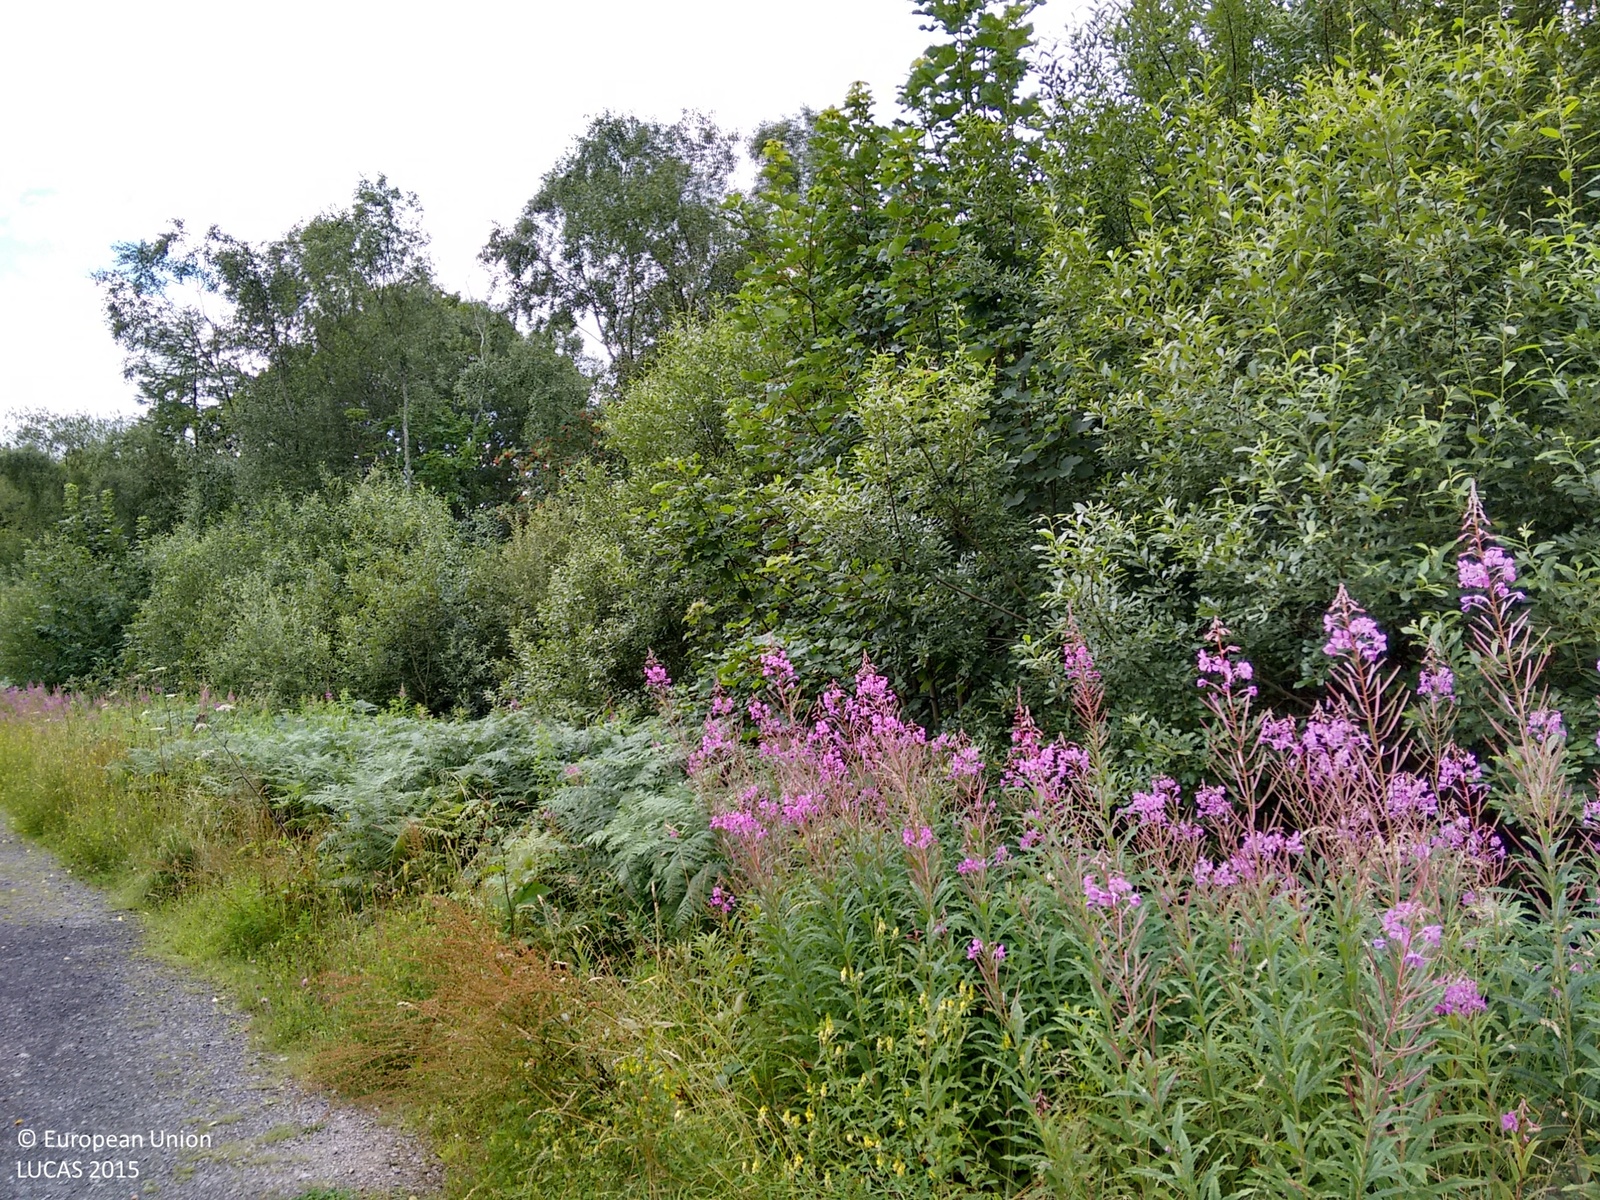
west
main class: Woodland
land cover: Broadleaved woodland
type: mesophytic deciduous forest
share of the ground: > 75 %
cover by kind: broadleaved forest trees 80 %, shrubs 20 %
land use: Forestry
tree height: > 5 m
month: July
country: GB
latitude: 51.6889
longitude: -3.9959
